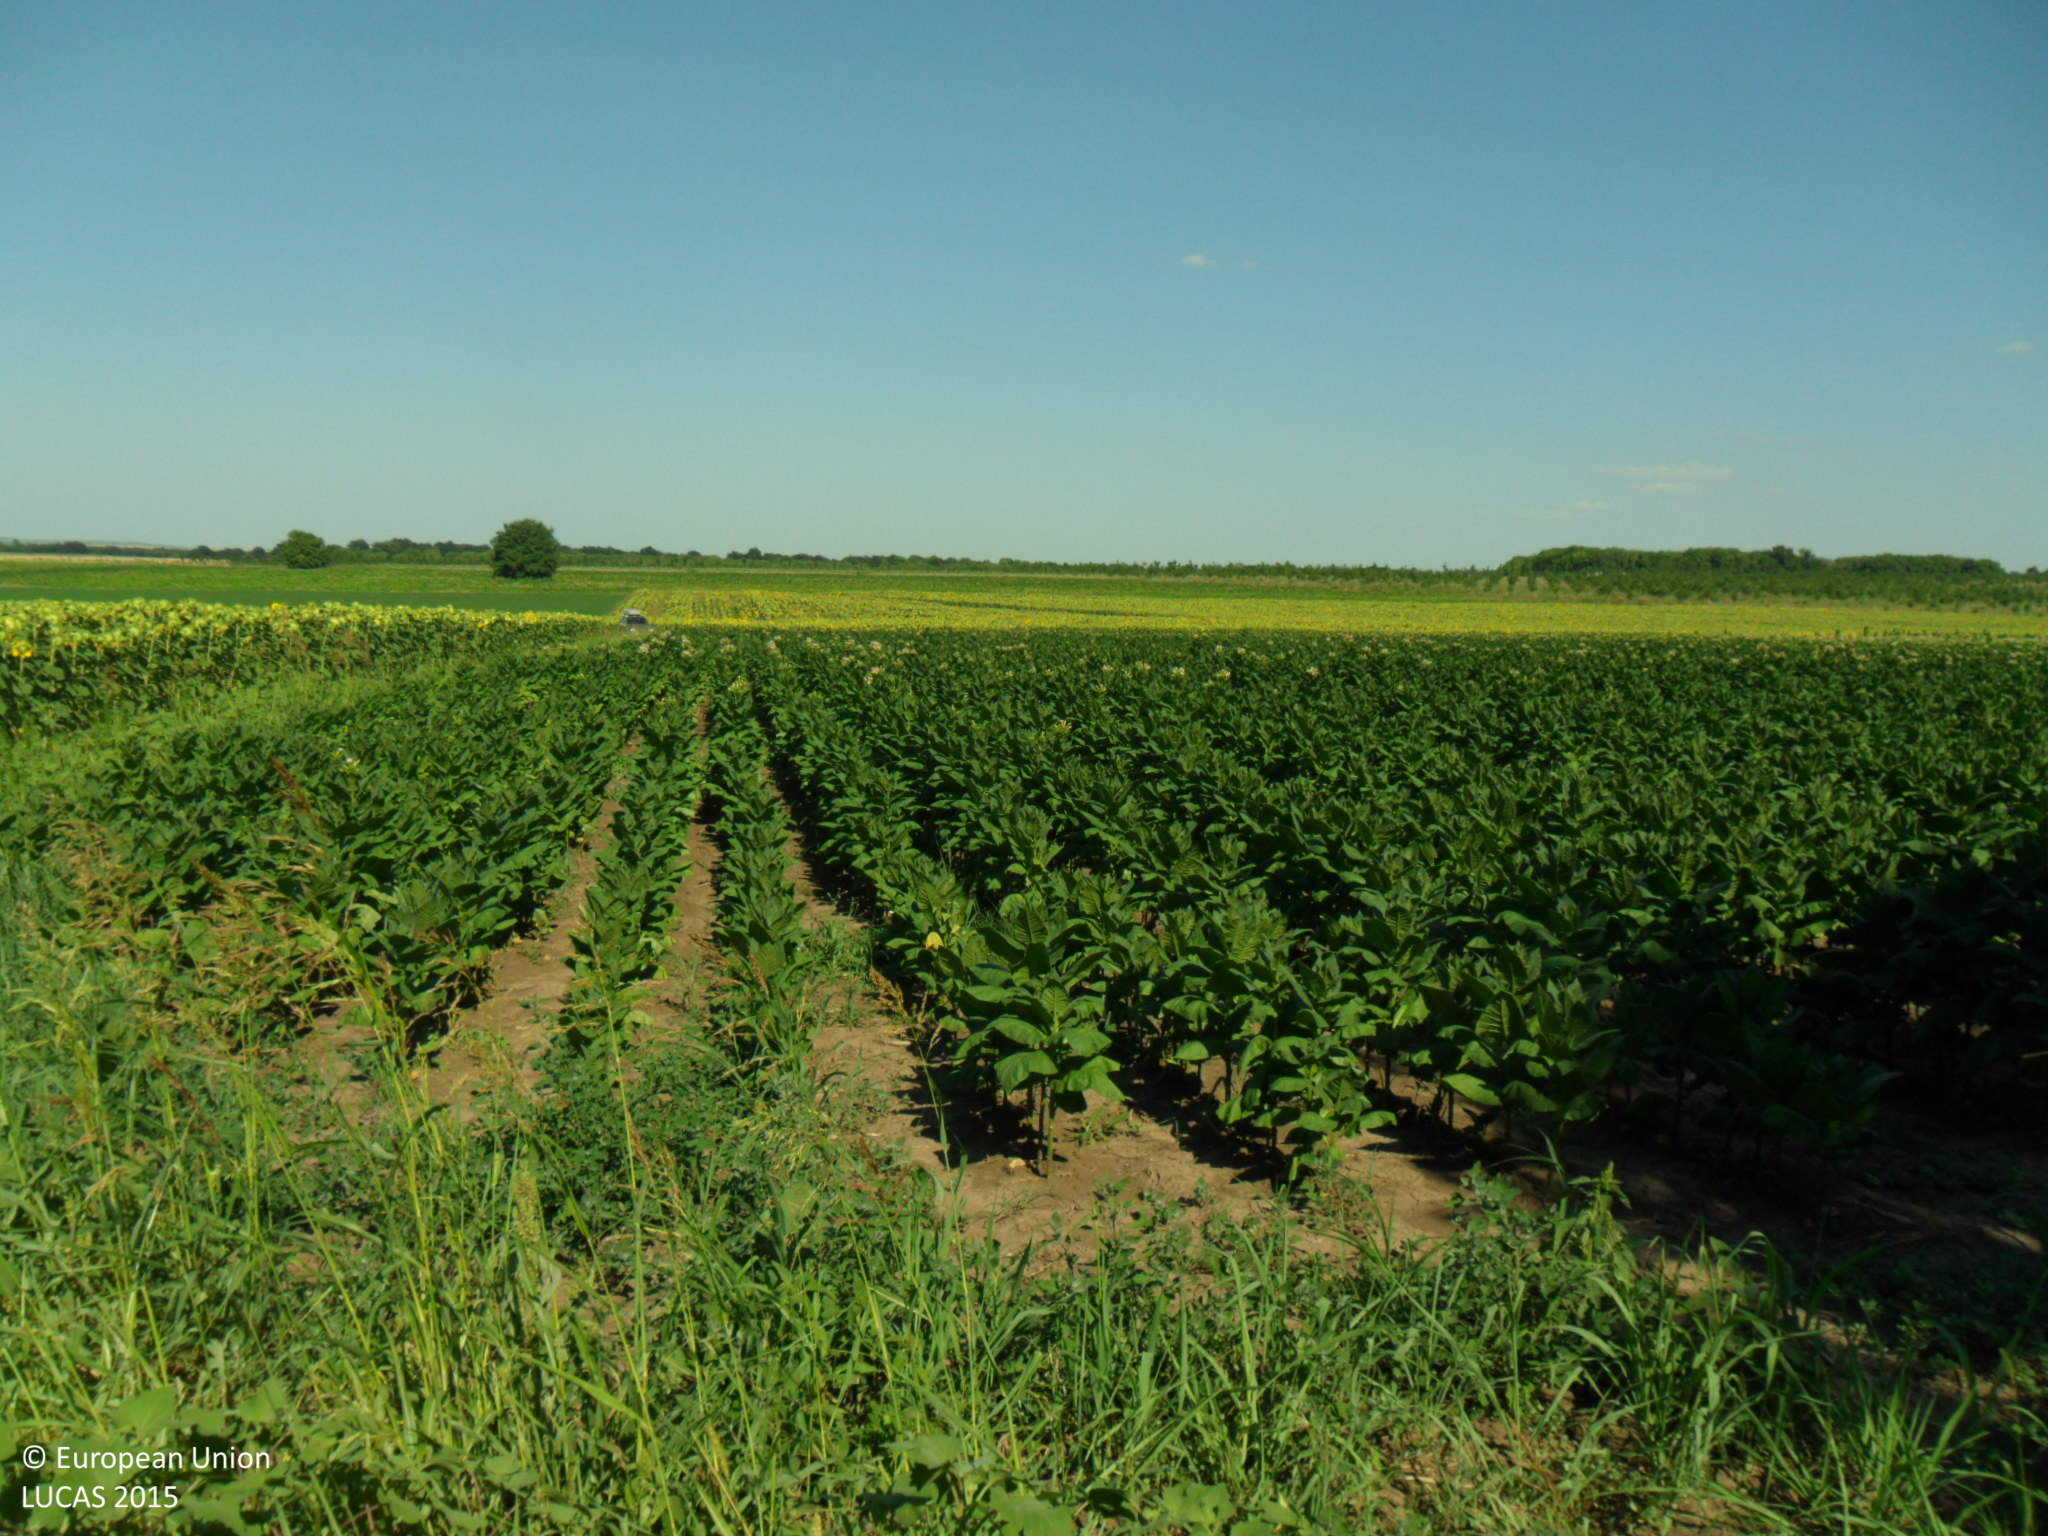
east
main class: Shrubland
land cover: Shrubland with sparse tree cover
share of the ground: > 75 %
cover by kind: shrubs 80 %, herbaceous plants 15 %, broadleaved forest trees 5 %
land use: Agriculture (excluding fallow land and kitchen gardens)
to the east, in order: Shrubland with sparse tree cover; Tobacco; Grass margins; Tracks; Grass margins; Sunflower; Grass margins; Tracks
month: July
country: BG
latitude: 43.8337
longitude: 26.4611
